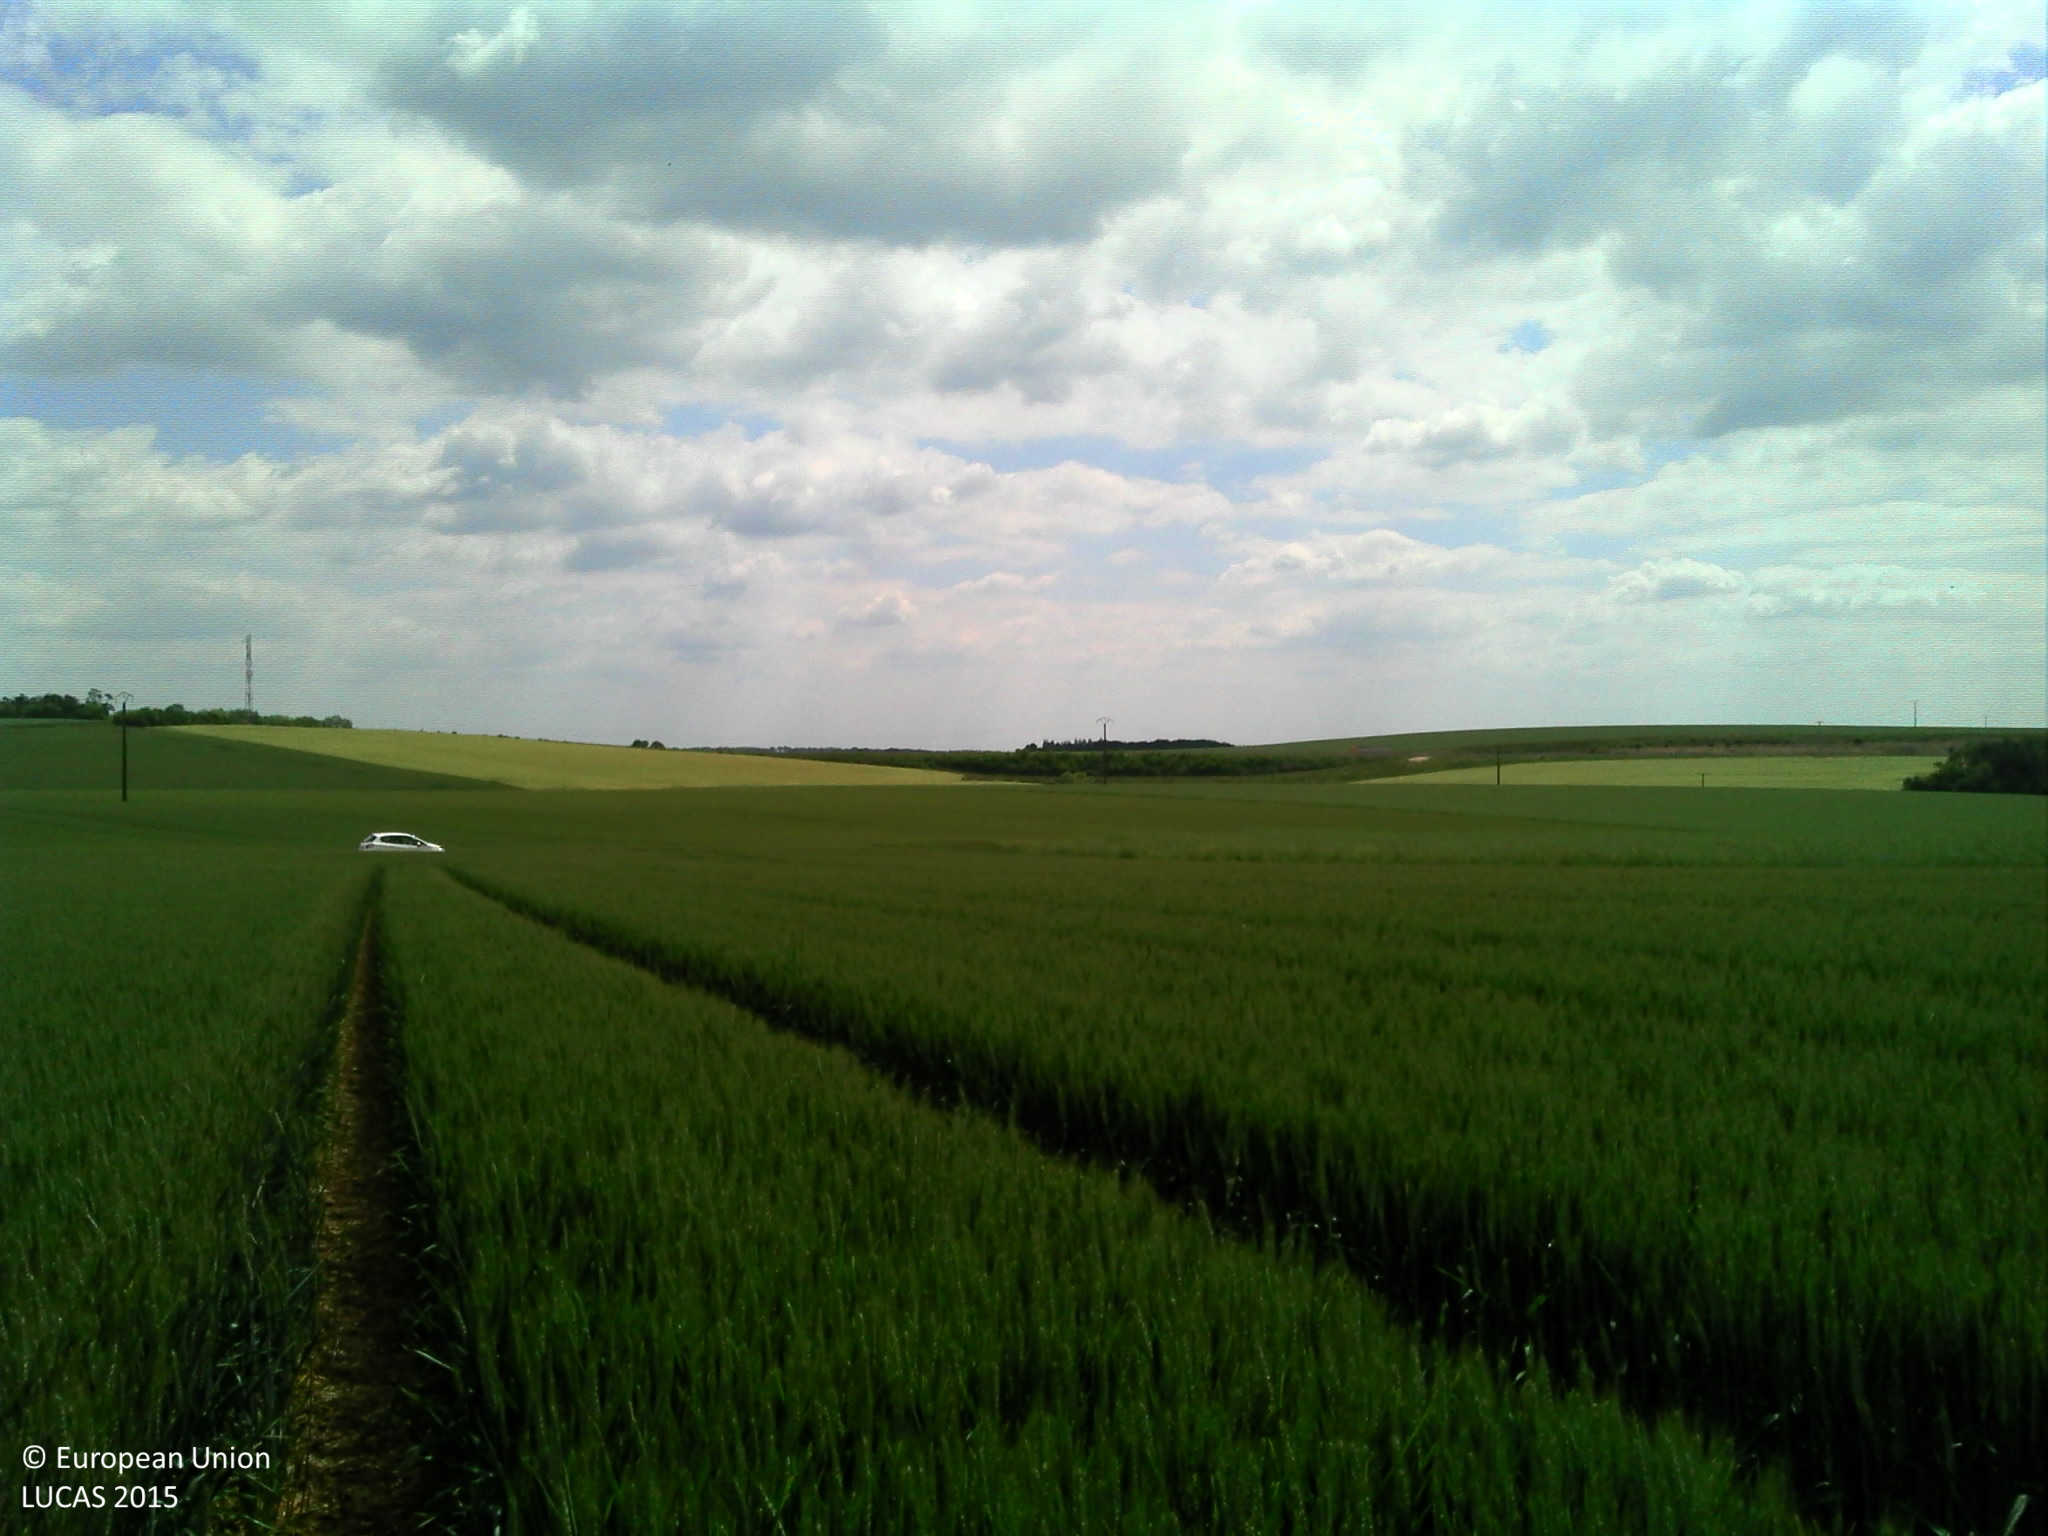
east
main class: Cropland
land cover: Common wheat
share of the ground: > 75 %
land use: Agriculture (excluding fallow land and kitchen gardens)
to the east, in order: Common wheat; Grass margins; Tracks; Grass margins; Common wheat
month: May
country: FR
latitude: 47.4502
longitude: 5.1596
